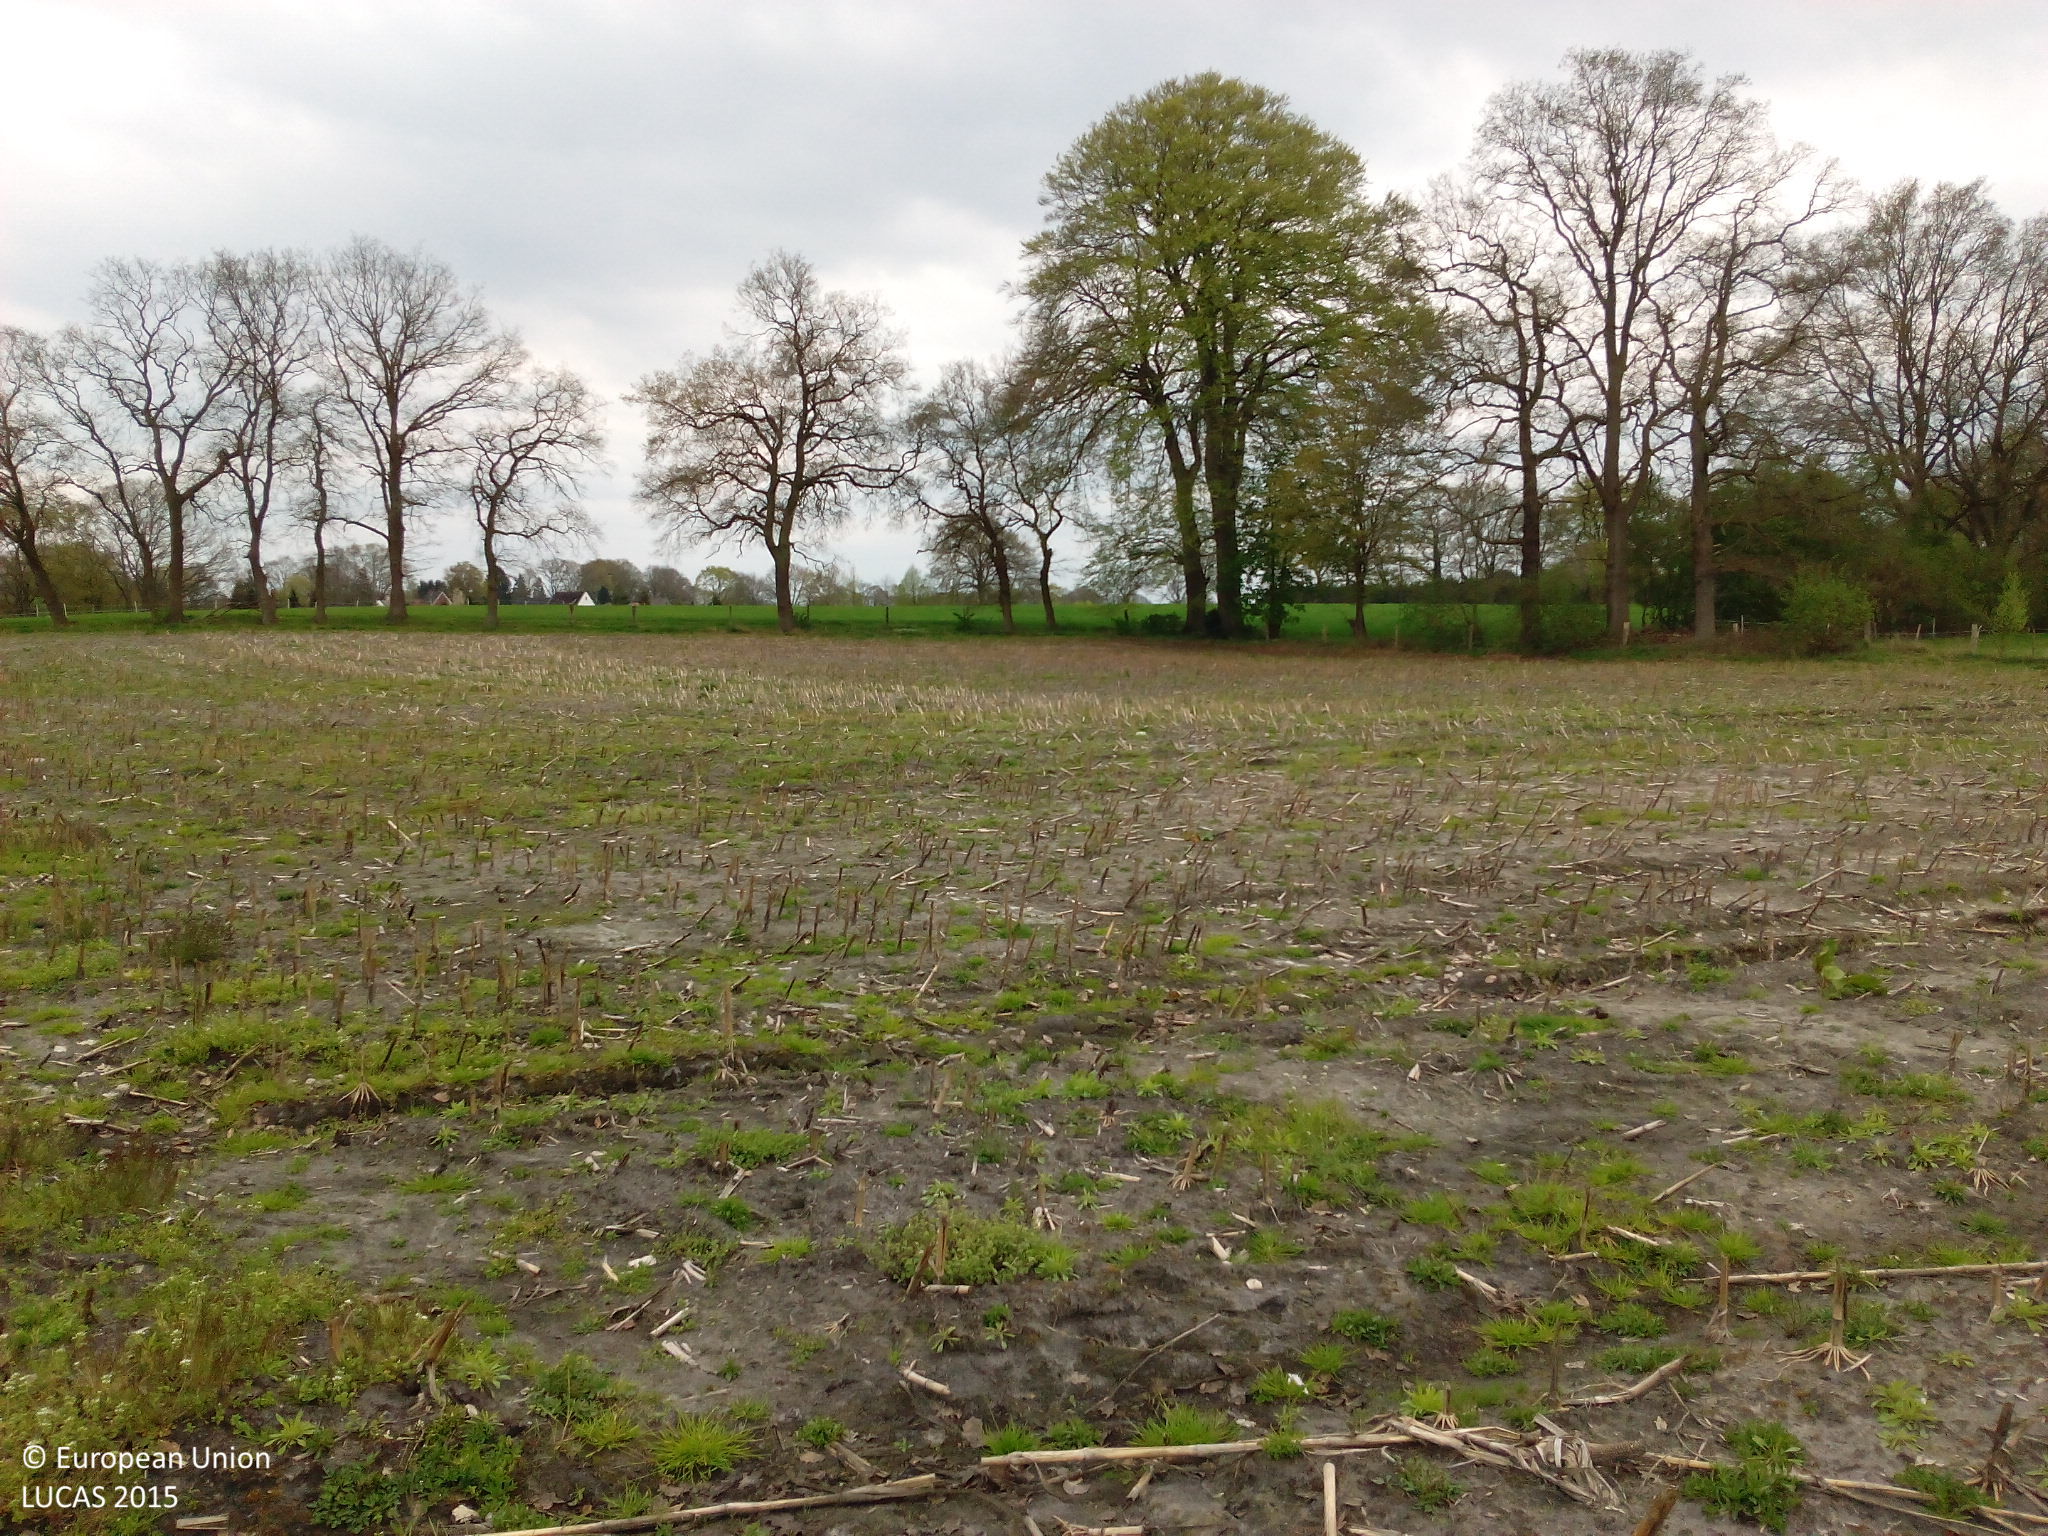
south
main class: Grassland
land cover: Spontaneously vegetated surfaces
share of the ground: 50 - 75 %
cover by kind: herbaceous plants 50 %, consolidated bare surface 30 %, lichens and mosses 20 %
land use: Fallow land
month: May
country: DE
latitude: 53.2498
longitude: 8.5768
